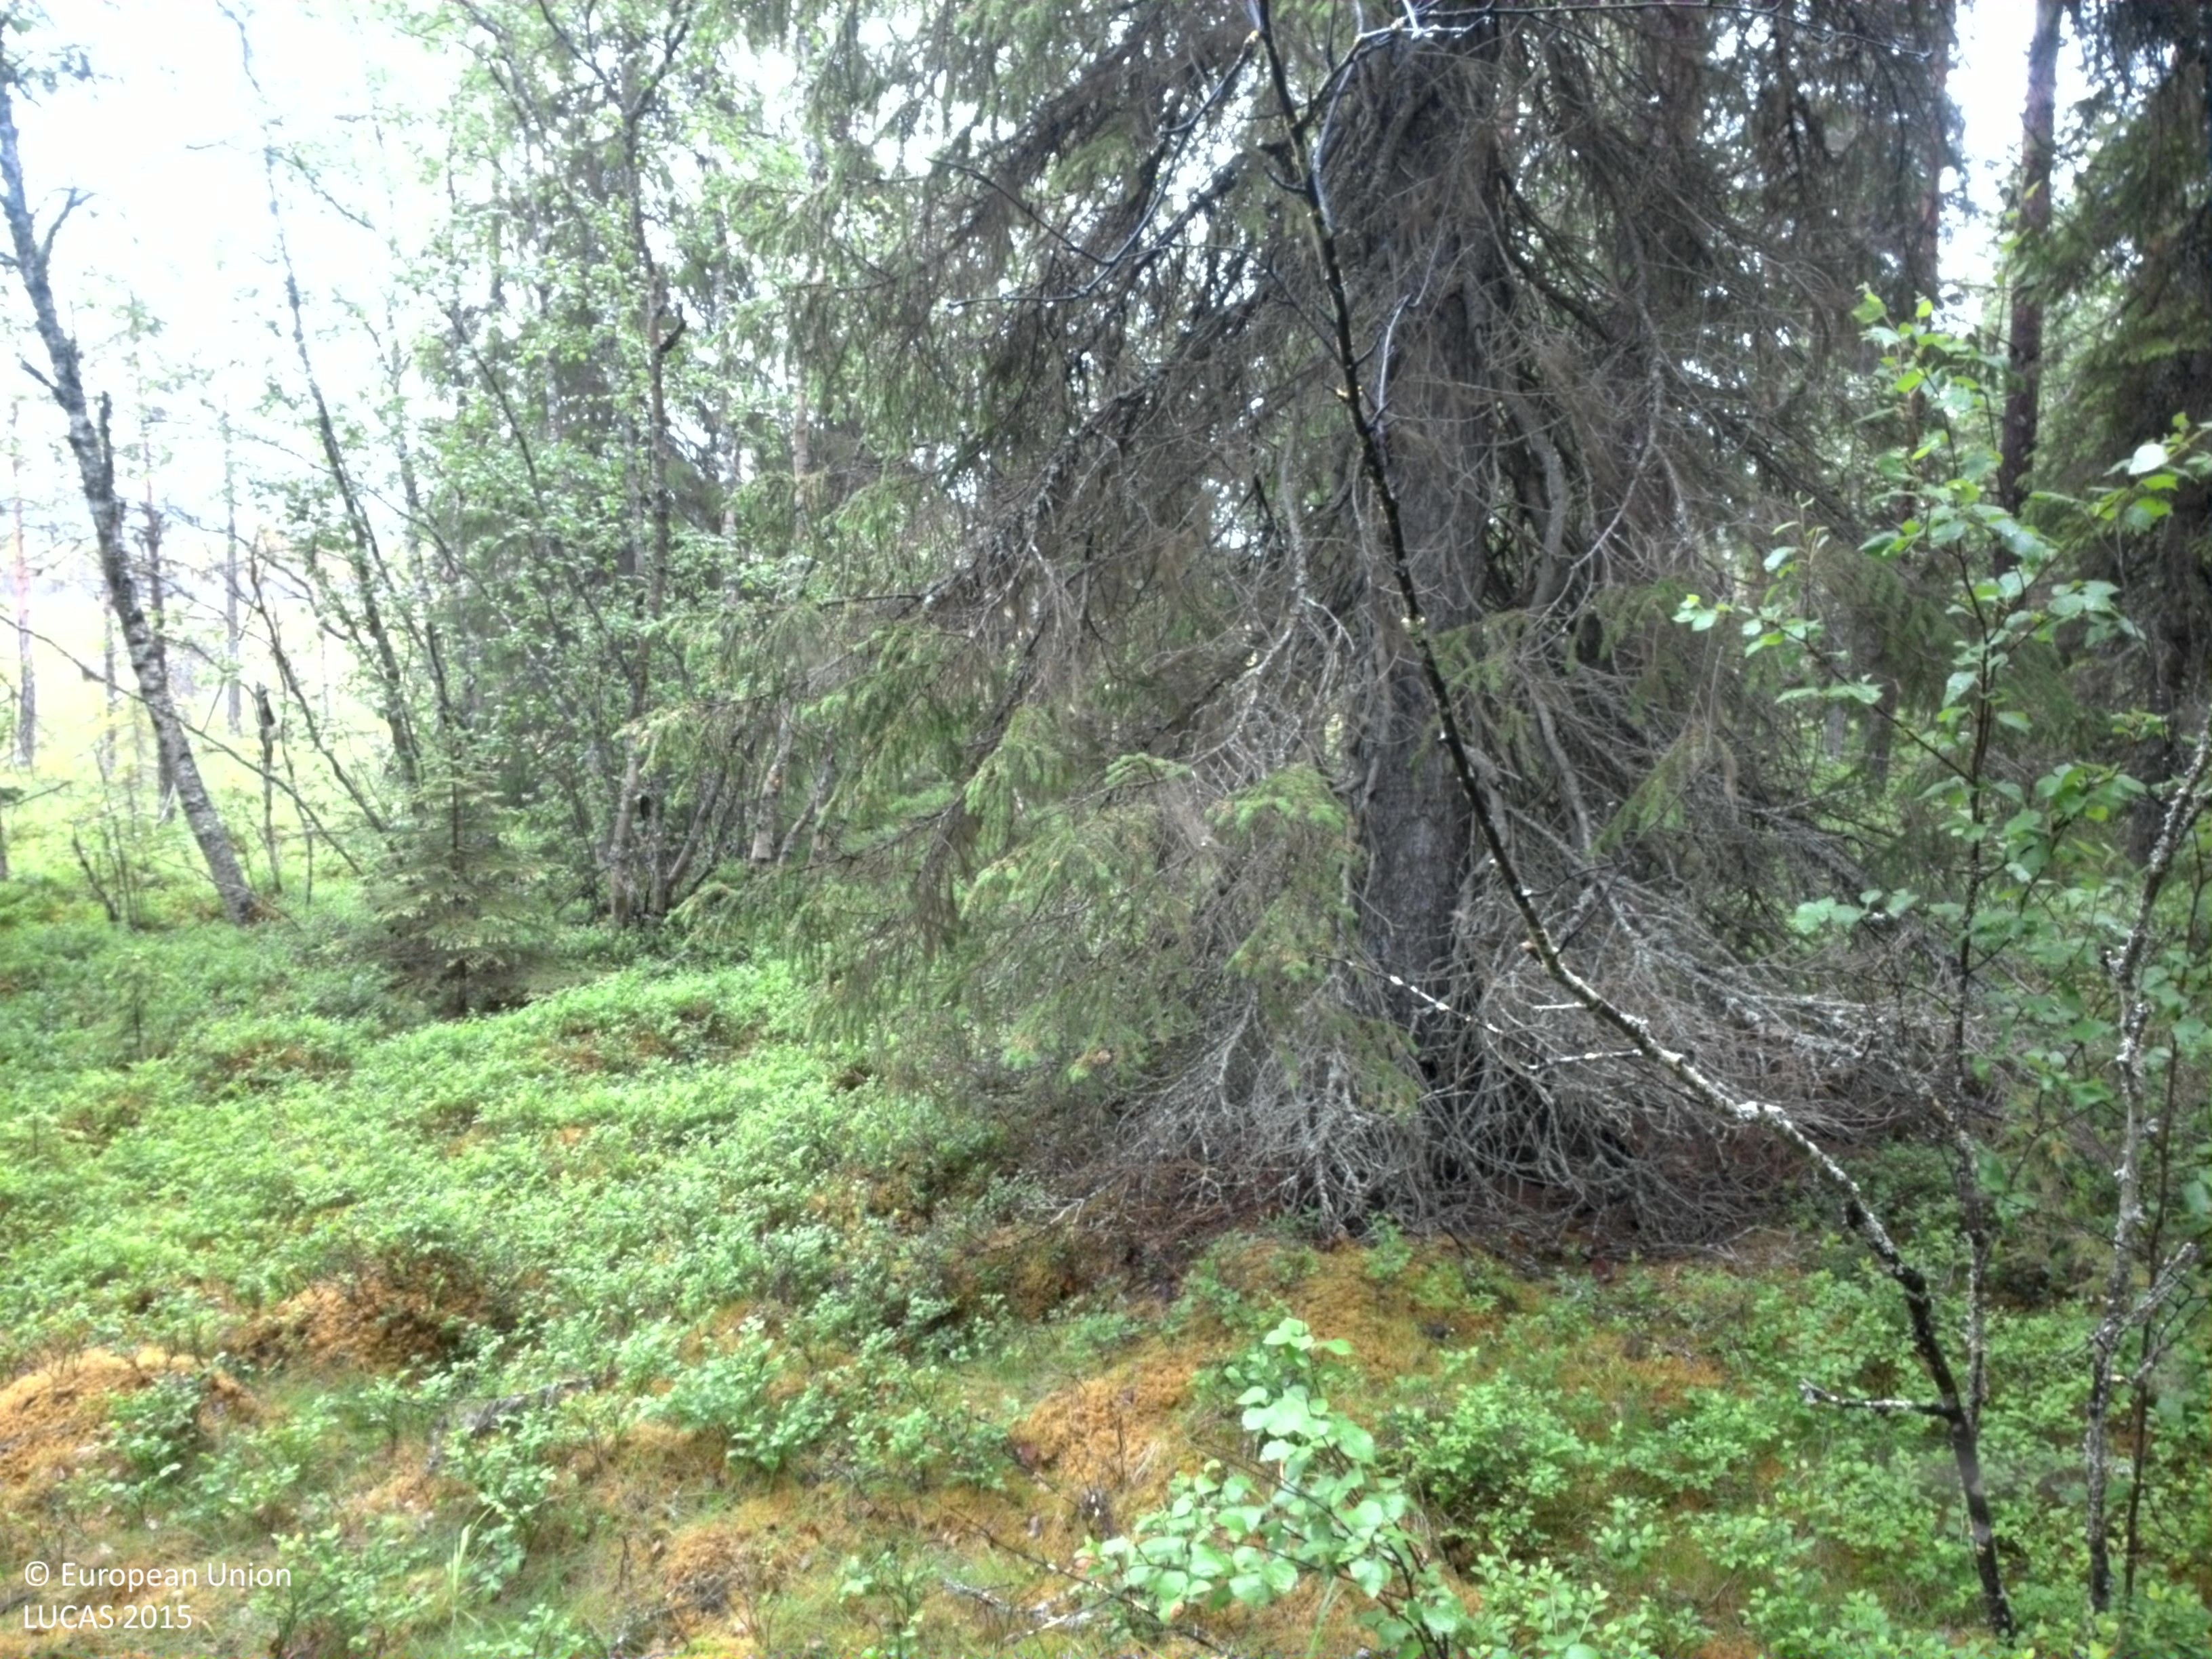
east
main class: Woodland
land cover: Pine dominated coniferous woodland
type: boreal forest
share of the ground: 50 - 75 %
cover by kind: coniferous forest trees 65 %, shrubs 20 %, broadleaved forest trees 10 %, lichens and mosses 5 %
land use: Forestry
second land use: Amenities, museums, leisure
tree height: > 5 m
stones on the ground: 25 - 50 %
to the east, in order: Pine dominated coniferous woodland; Peatbogs; Pine dominated coniferous woodland
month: July
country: SE
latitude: 64.6365
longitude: 18.2732
